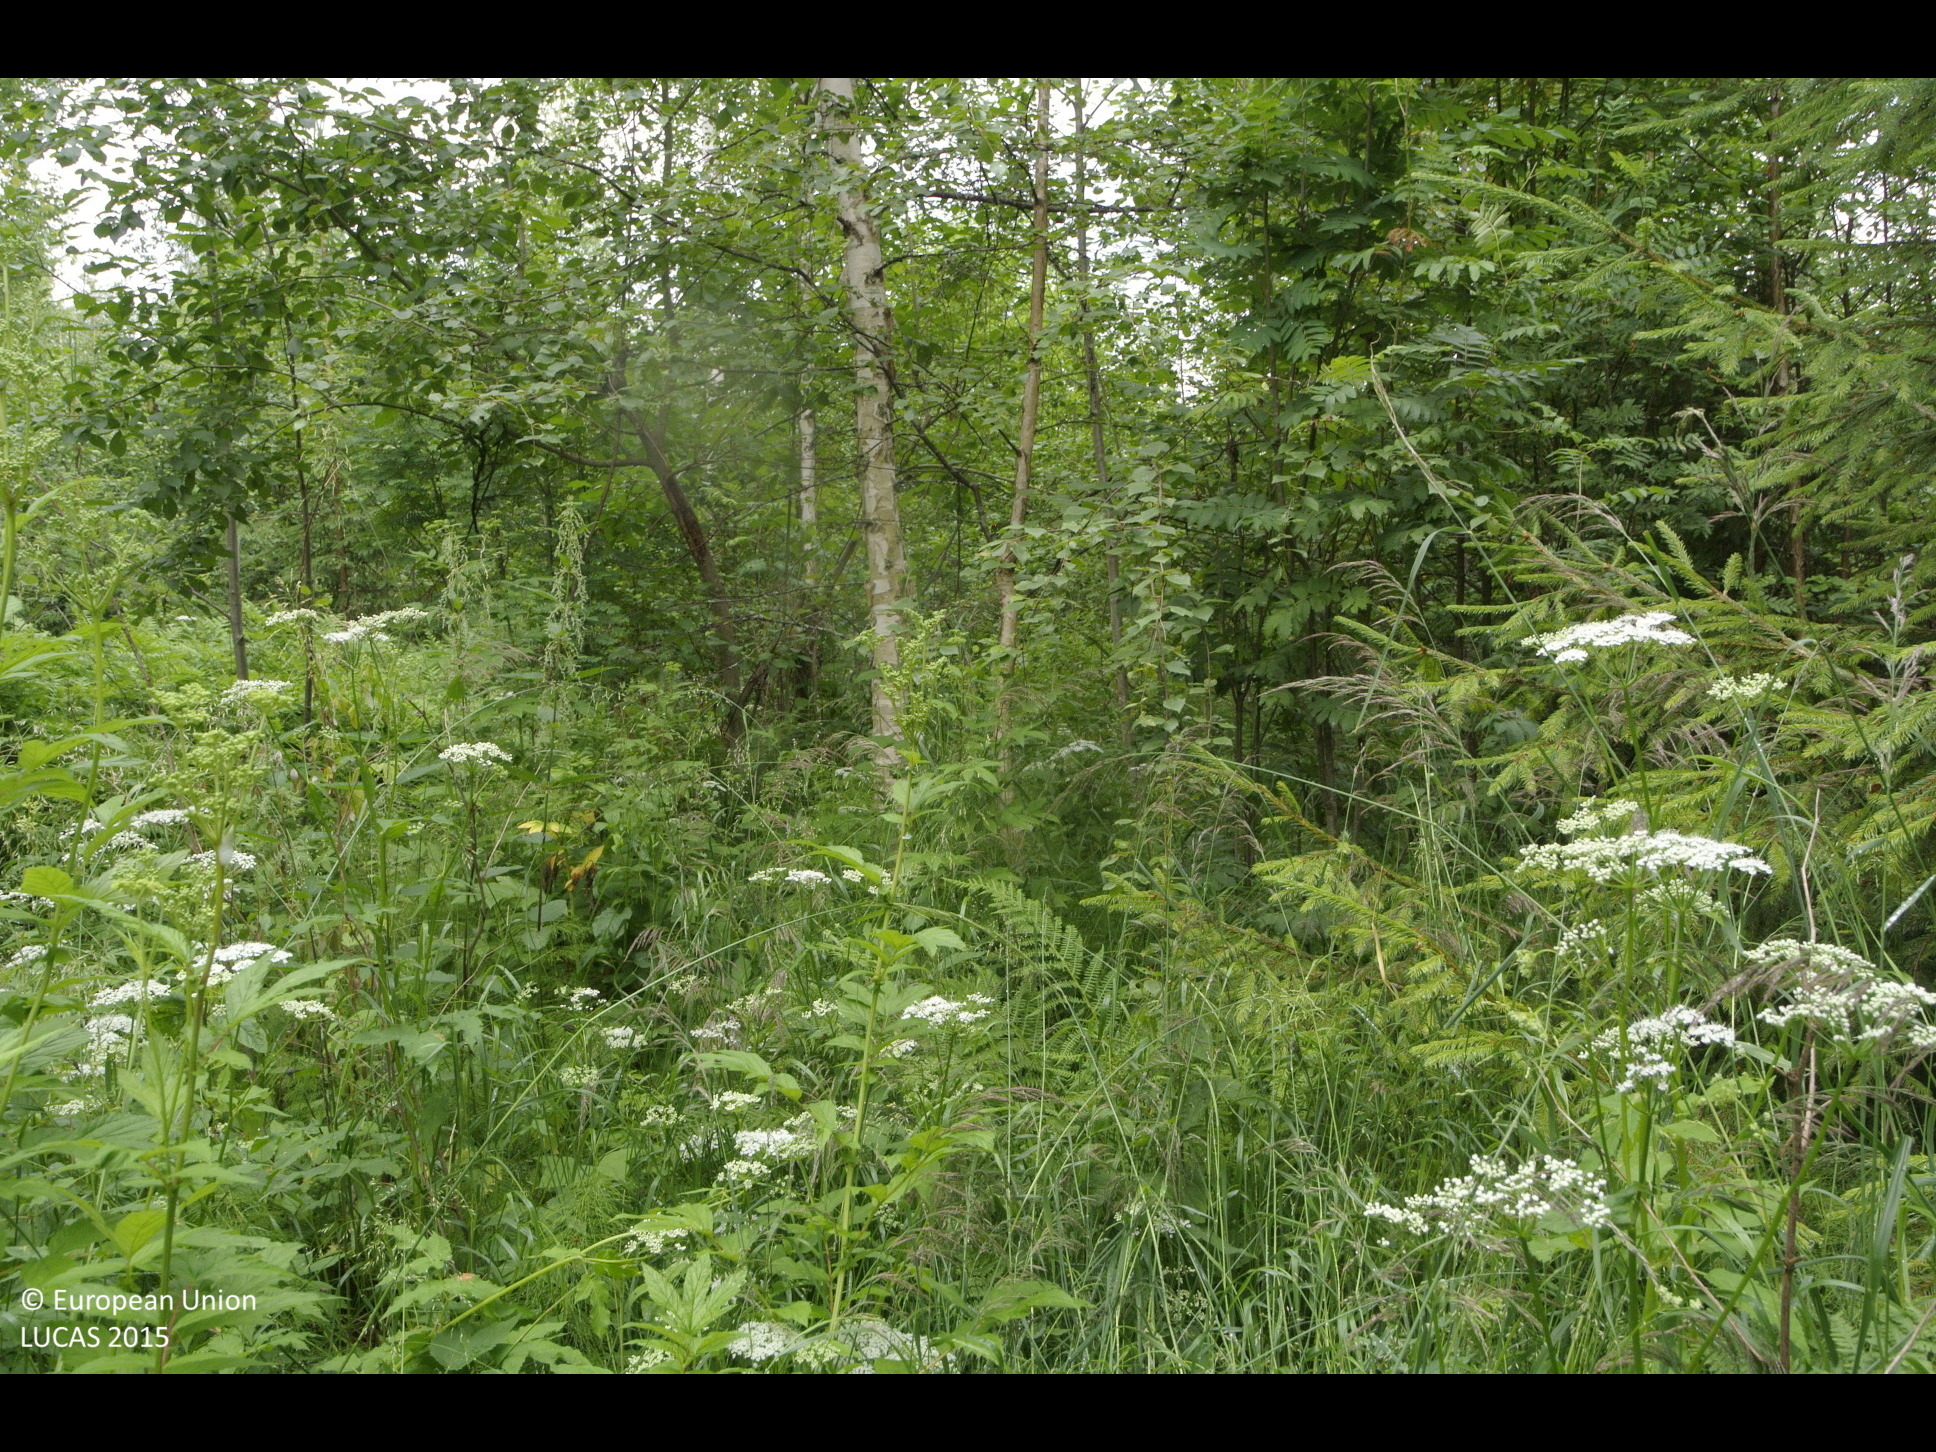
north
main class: Grassland
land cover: Grassland with sparse tree/shrub cover
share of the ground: > 75 %
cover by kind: herbaceous plants 90 %, coniferous forest trees 5 %, shrubs 5 %
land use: Semi-natural and natural areas not in use
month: July
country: FI
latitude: 61.5093
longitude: 25.8207
